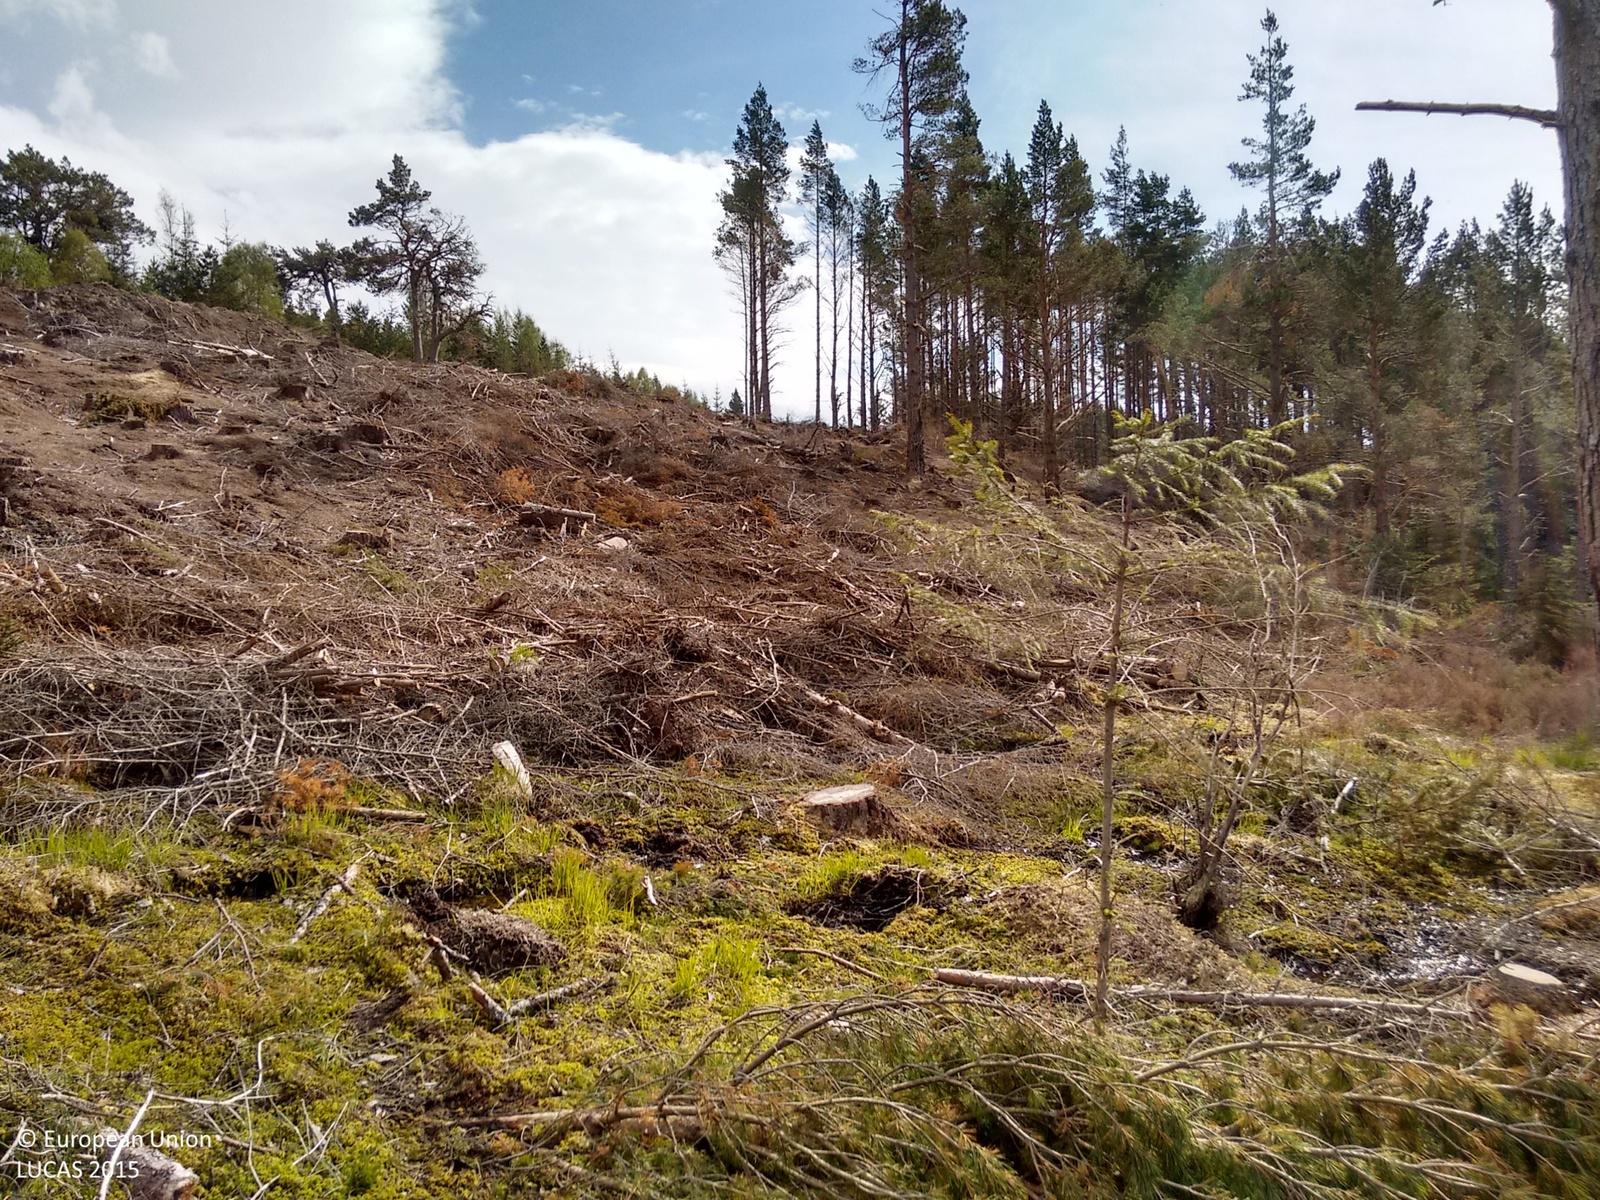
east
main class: Woodland
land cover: Pine dominated coniferous woodland
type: hemiboreal forest and nemoral coniferous forest and mixed broadleaved-coniferous forest
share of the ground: 25 - 50 %
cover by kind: lichens and mosses 50 %, coniferous forest trees 30 %
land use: Forestry
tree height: > 5 m
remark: Clear cut
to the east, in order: Pine dominated coniferous woodland; Ponds and wetlands; Other bare soil; Pine dominated coniferous woodland; Other bare soil; Single bushes/trees; Other bare soil; Single bushes/trees; Other bare soil; Other mixed woodland; Pine dominated coniferous woodland
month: June
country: GB
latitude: 57.1675
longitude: -3.6856
